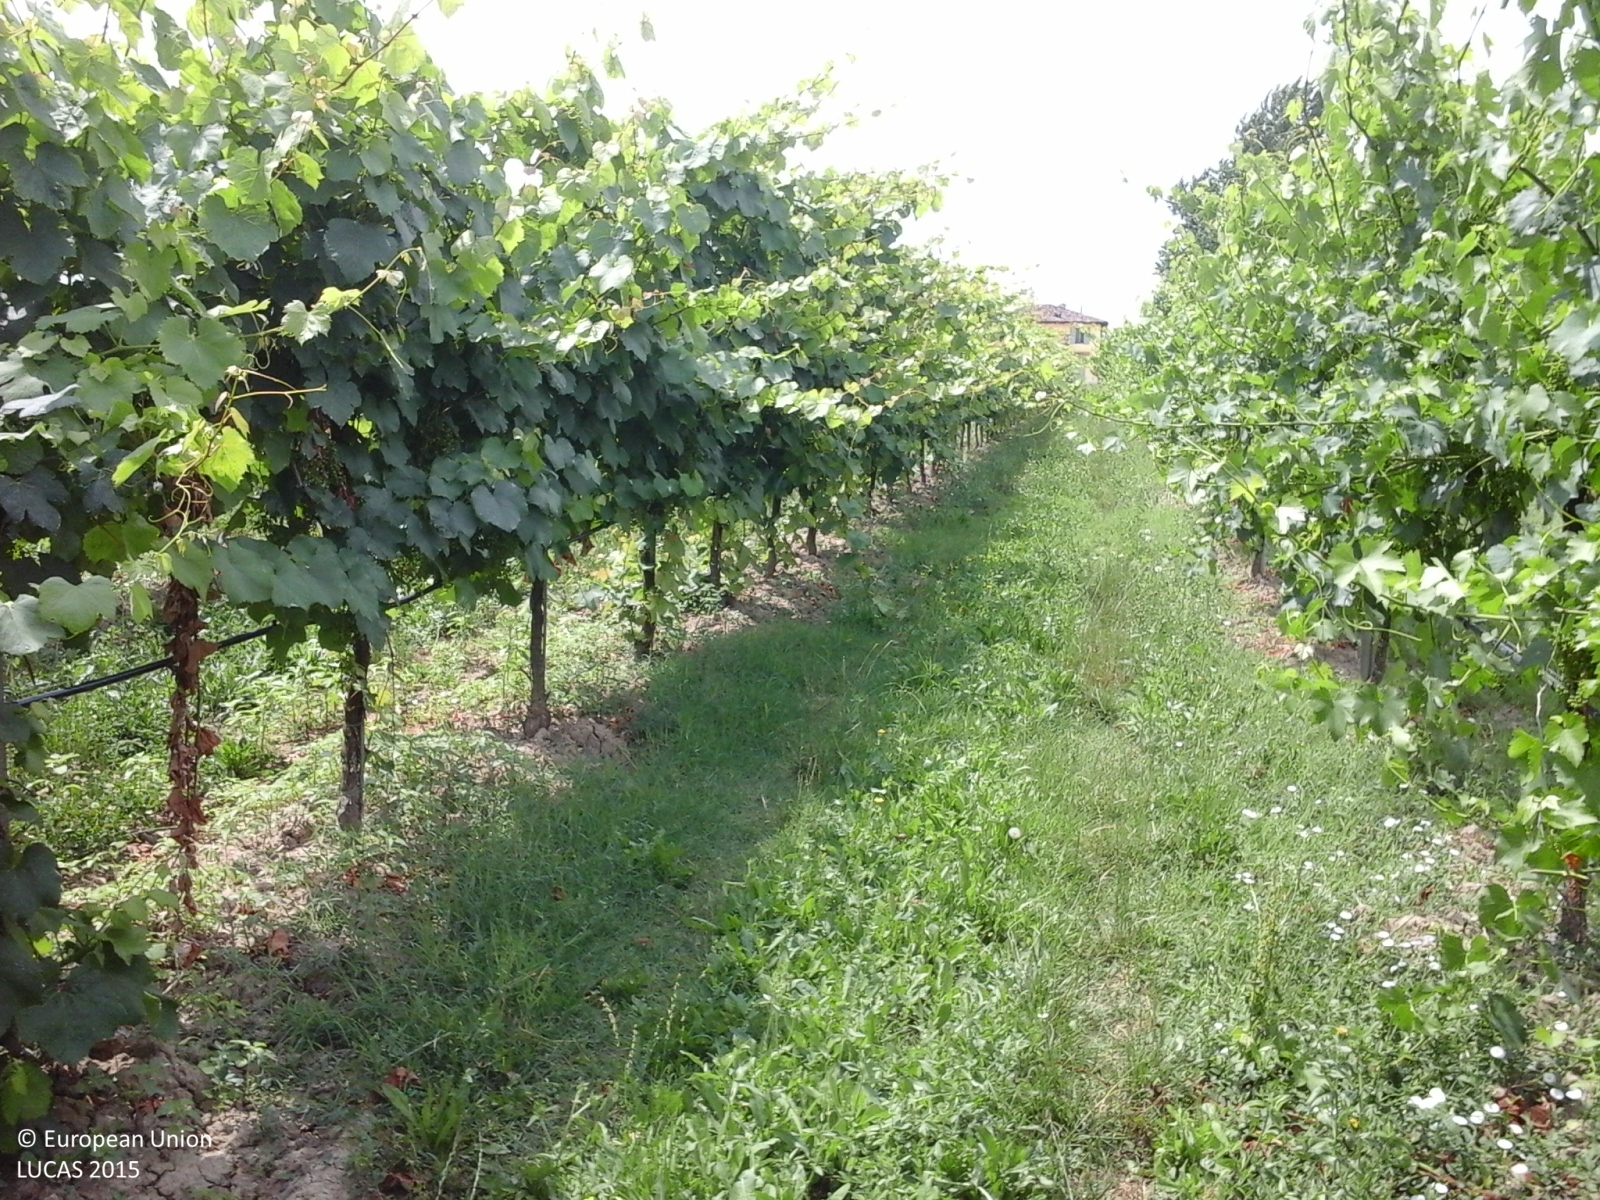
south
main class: Cropland
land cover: Vineyards
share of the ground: 50 - 75 %
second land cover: Grassland without tree/shrub cover
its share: > 75 %
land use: Agriculture (excluding fallow land and kitchen gardens)
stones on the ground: < 10 %
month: June
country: IT
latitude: 44.6519
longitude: 11.0444
